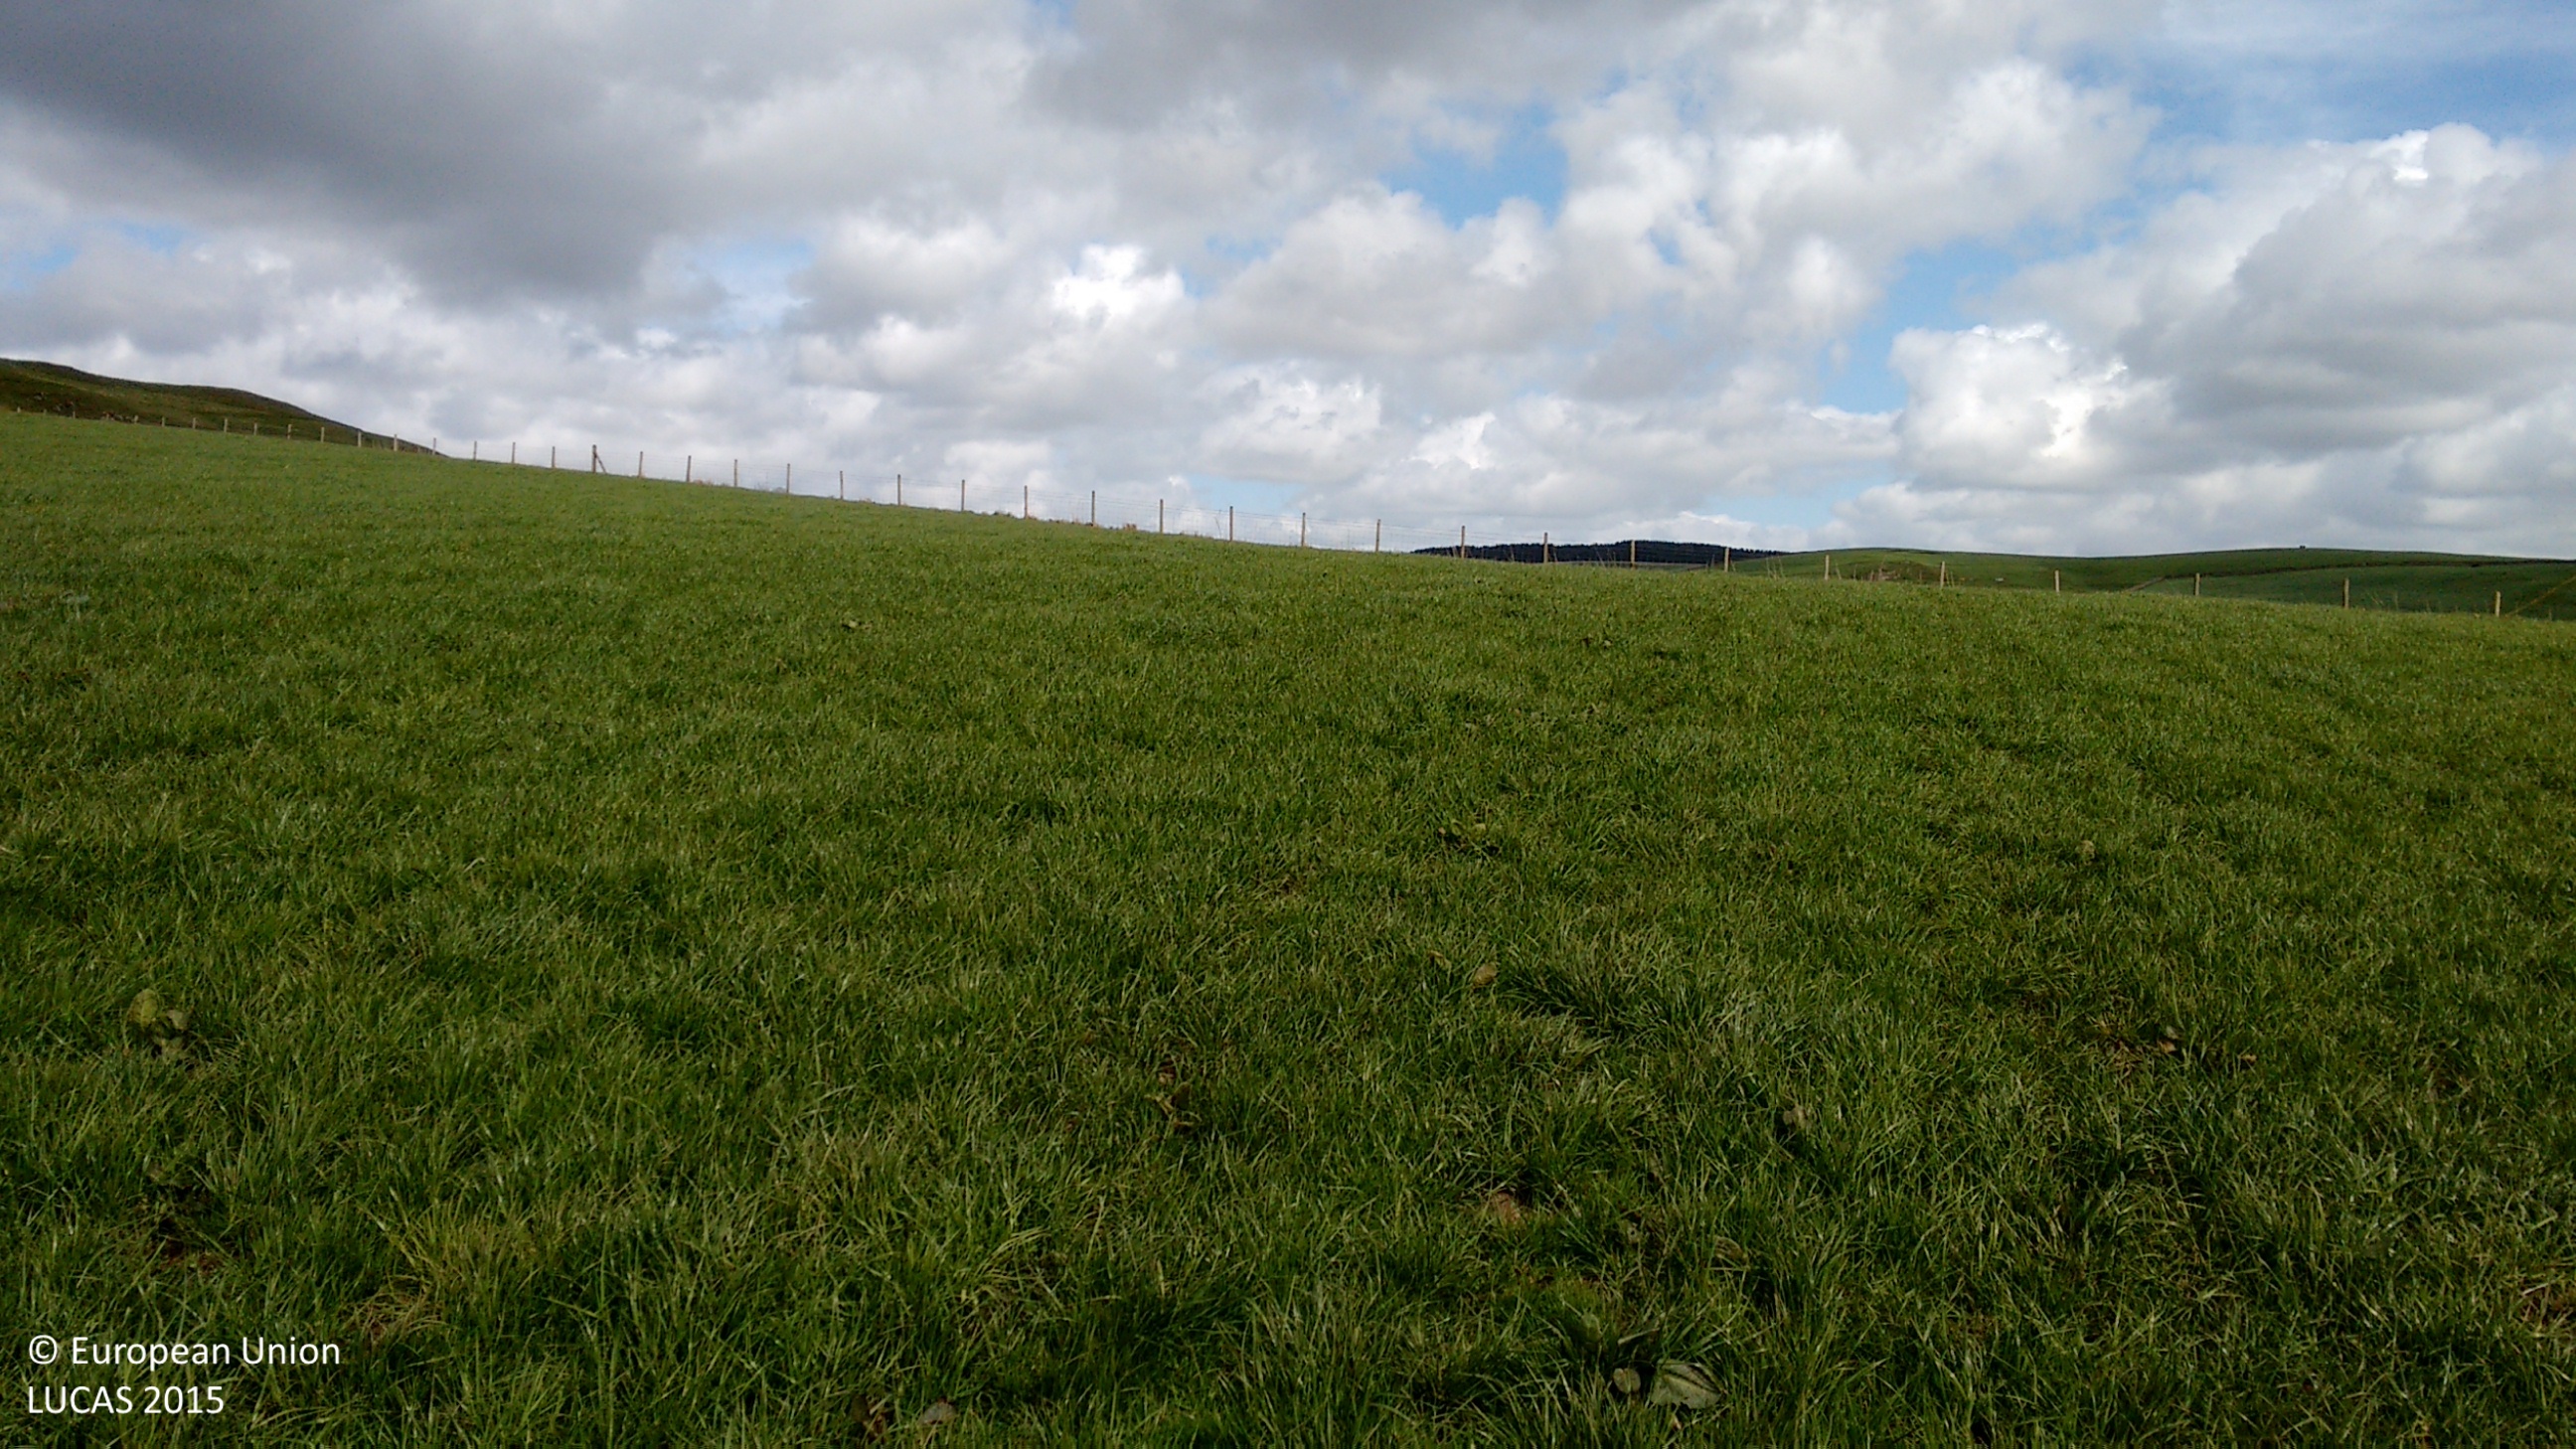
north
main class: Grassland
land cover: Grassland without tree/shrub cover
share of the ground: > 75 %
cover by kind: herbaceous plants 100 %
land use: Agriculture (excluding fallow land and kitchen gardens)
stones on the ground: < 10 %
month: April
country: GB
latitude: 53.9127
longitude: -2.5337
